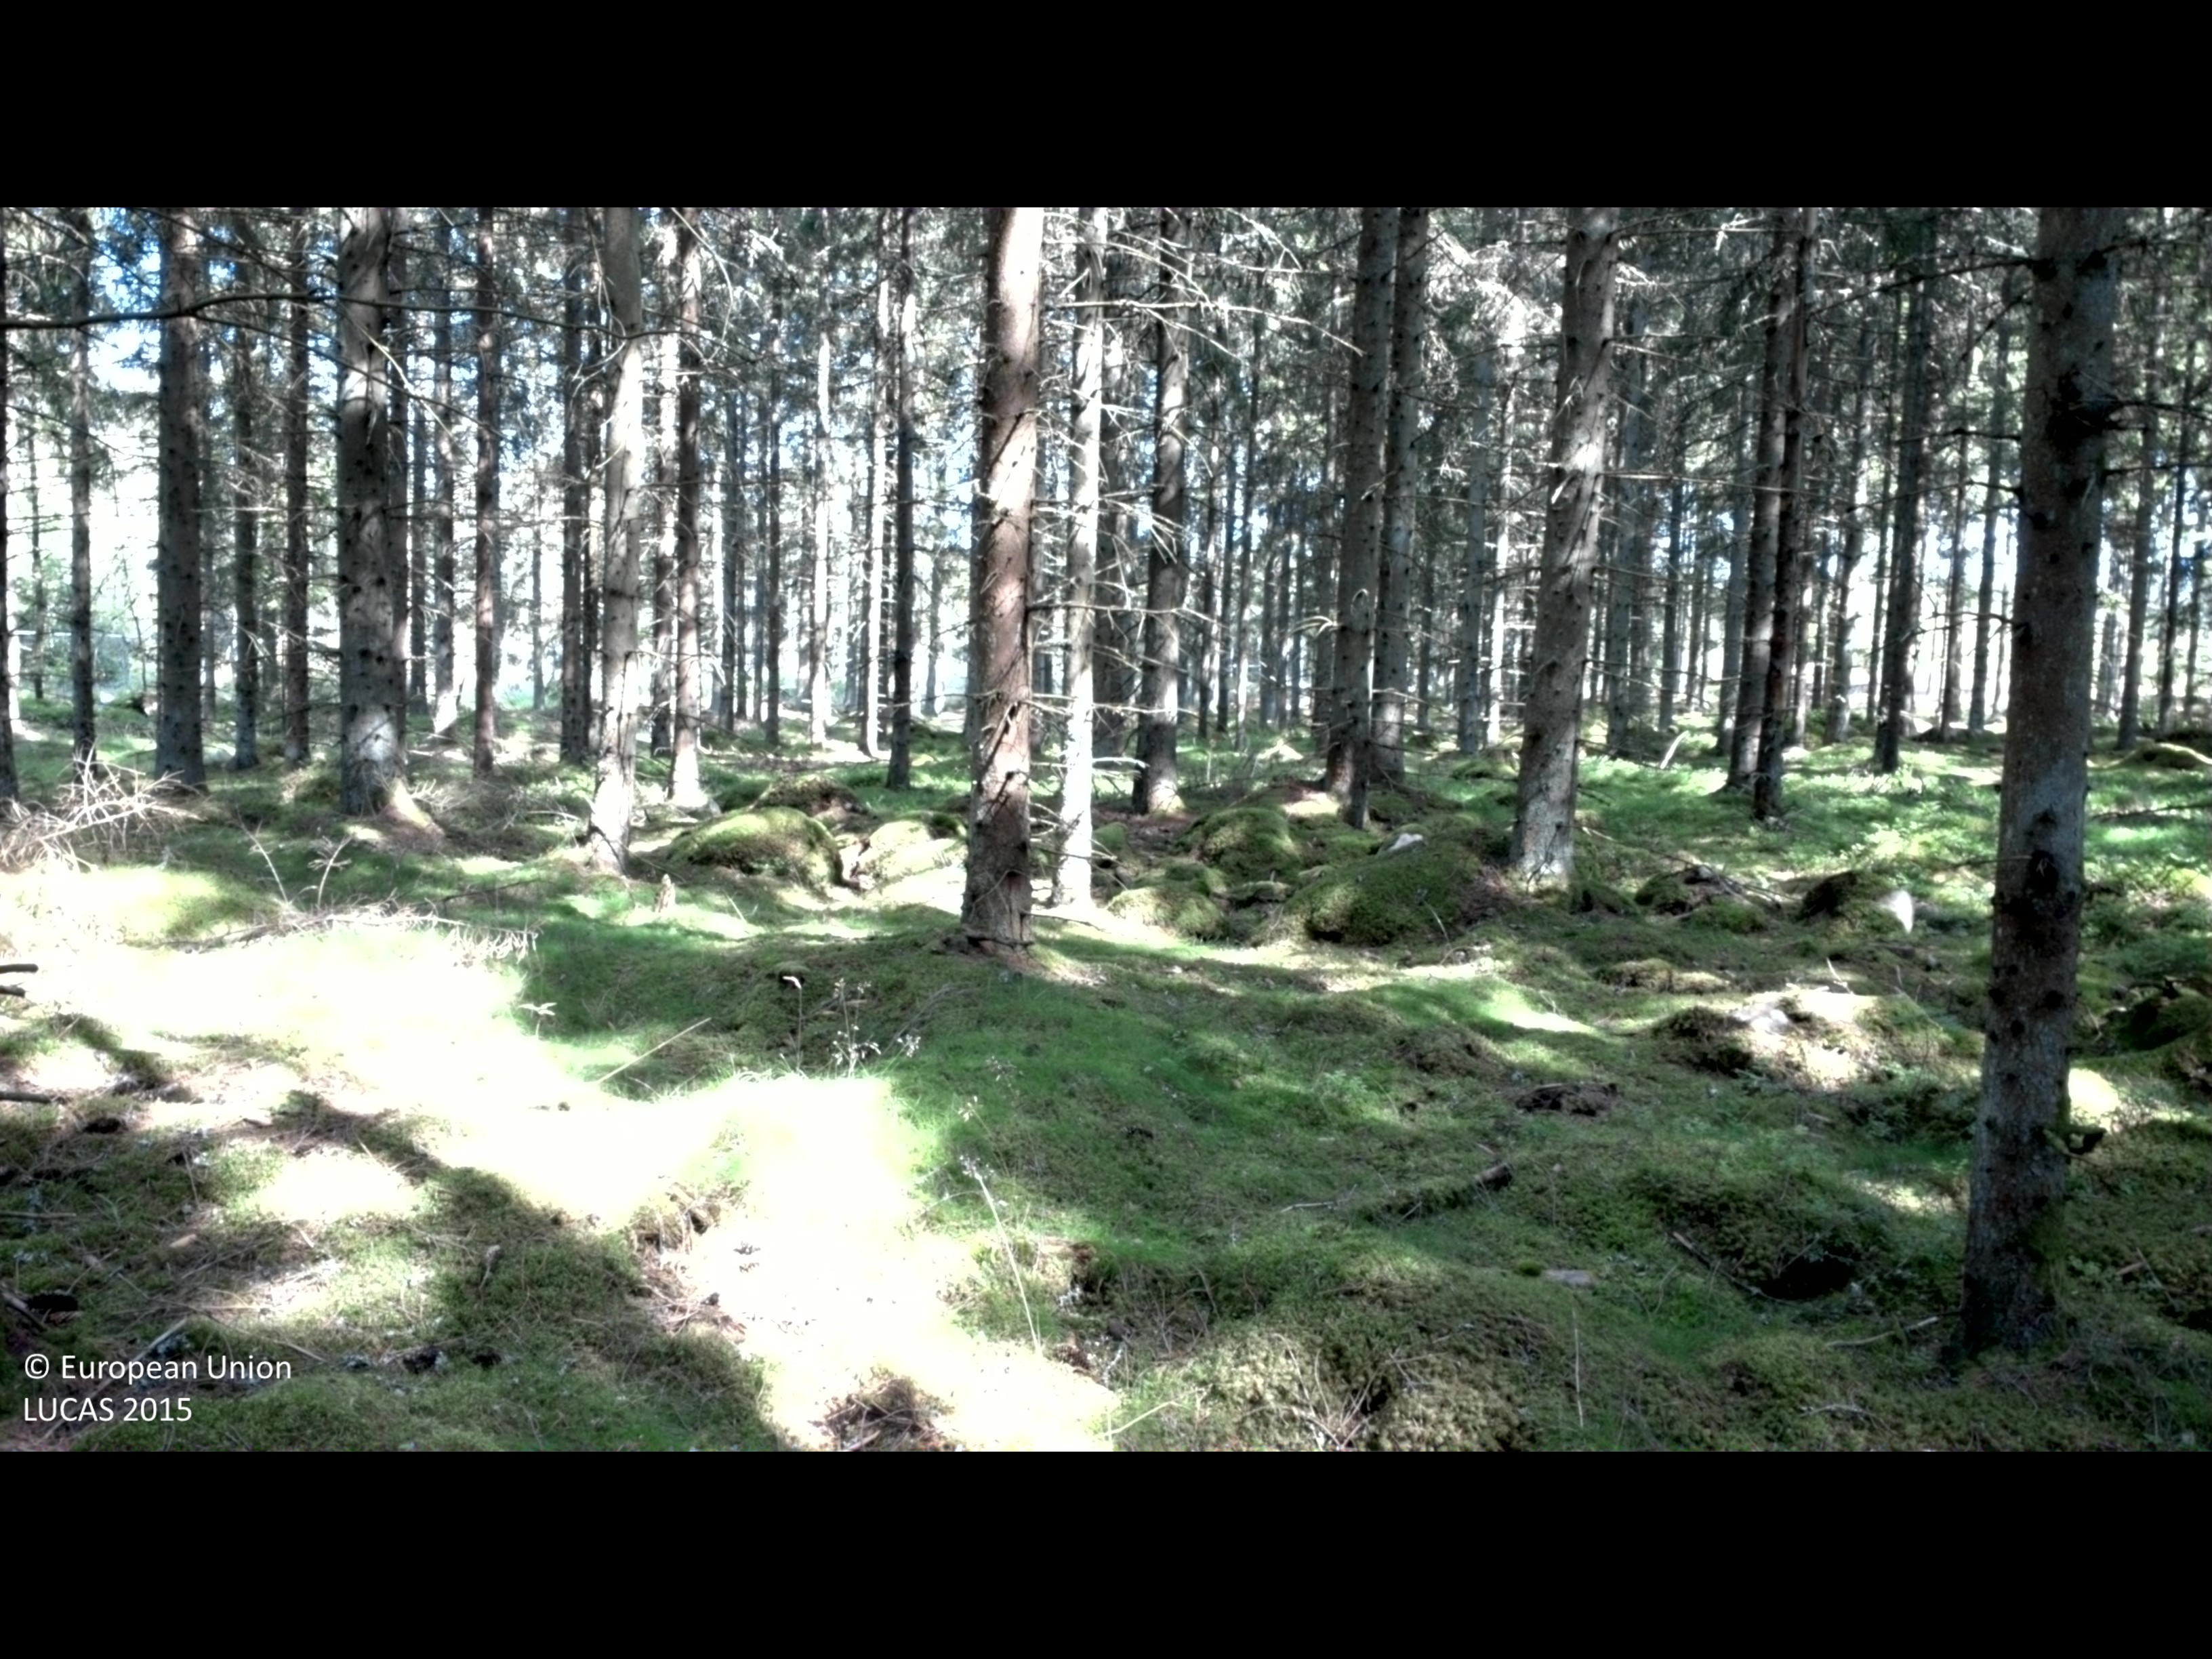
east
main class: Woodland
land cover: Spruce dominated coniferous woodland
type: boreal forest
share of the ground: > 75 %
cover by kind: coniferous forest trees 80 %, lichens and mosses 15 %, shrubs 5 %
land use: Forestry
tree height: > 5 m
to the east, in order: Spruce dominated coniferous woodland; Tracks; Spruce dominated coniferous woodland; Paved roads, cycling and walking lanes; Fences; Shrubland with sparse tree cover; Spruce dominated mixed woodland; Ditches and canals; Spruce dominated mixed woodland; Broadleaved woodland; Spruce dominated mixed woodland; Broadleaved woodland; Ditches and canals; Pine dominated mixed woodland
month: August
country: SE
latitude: 56.8580
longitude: 14.1787
